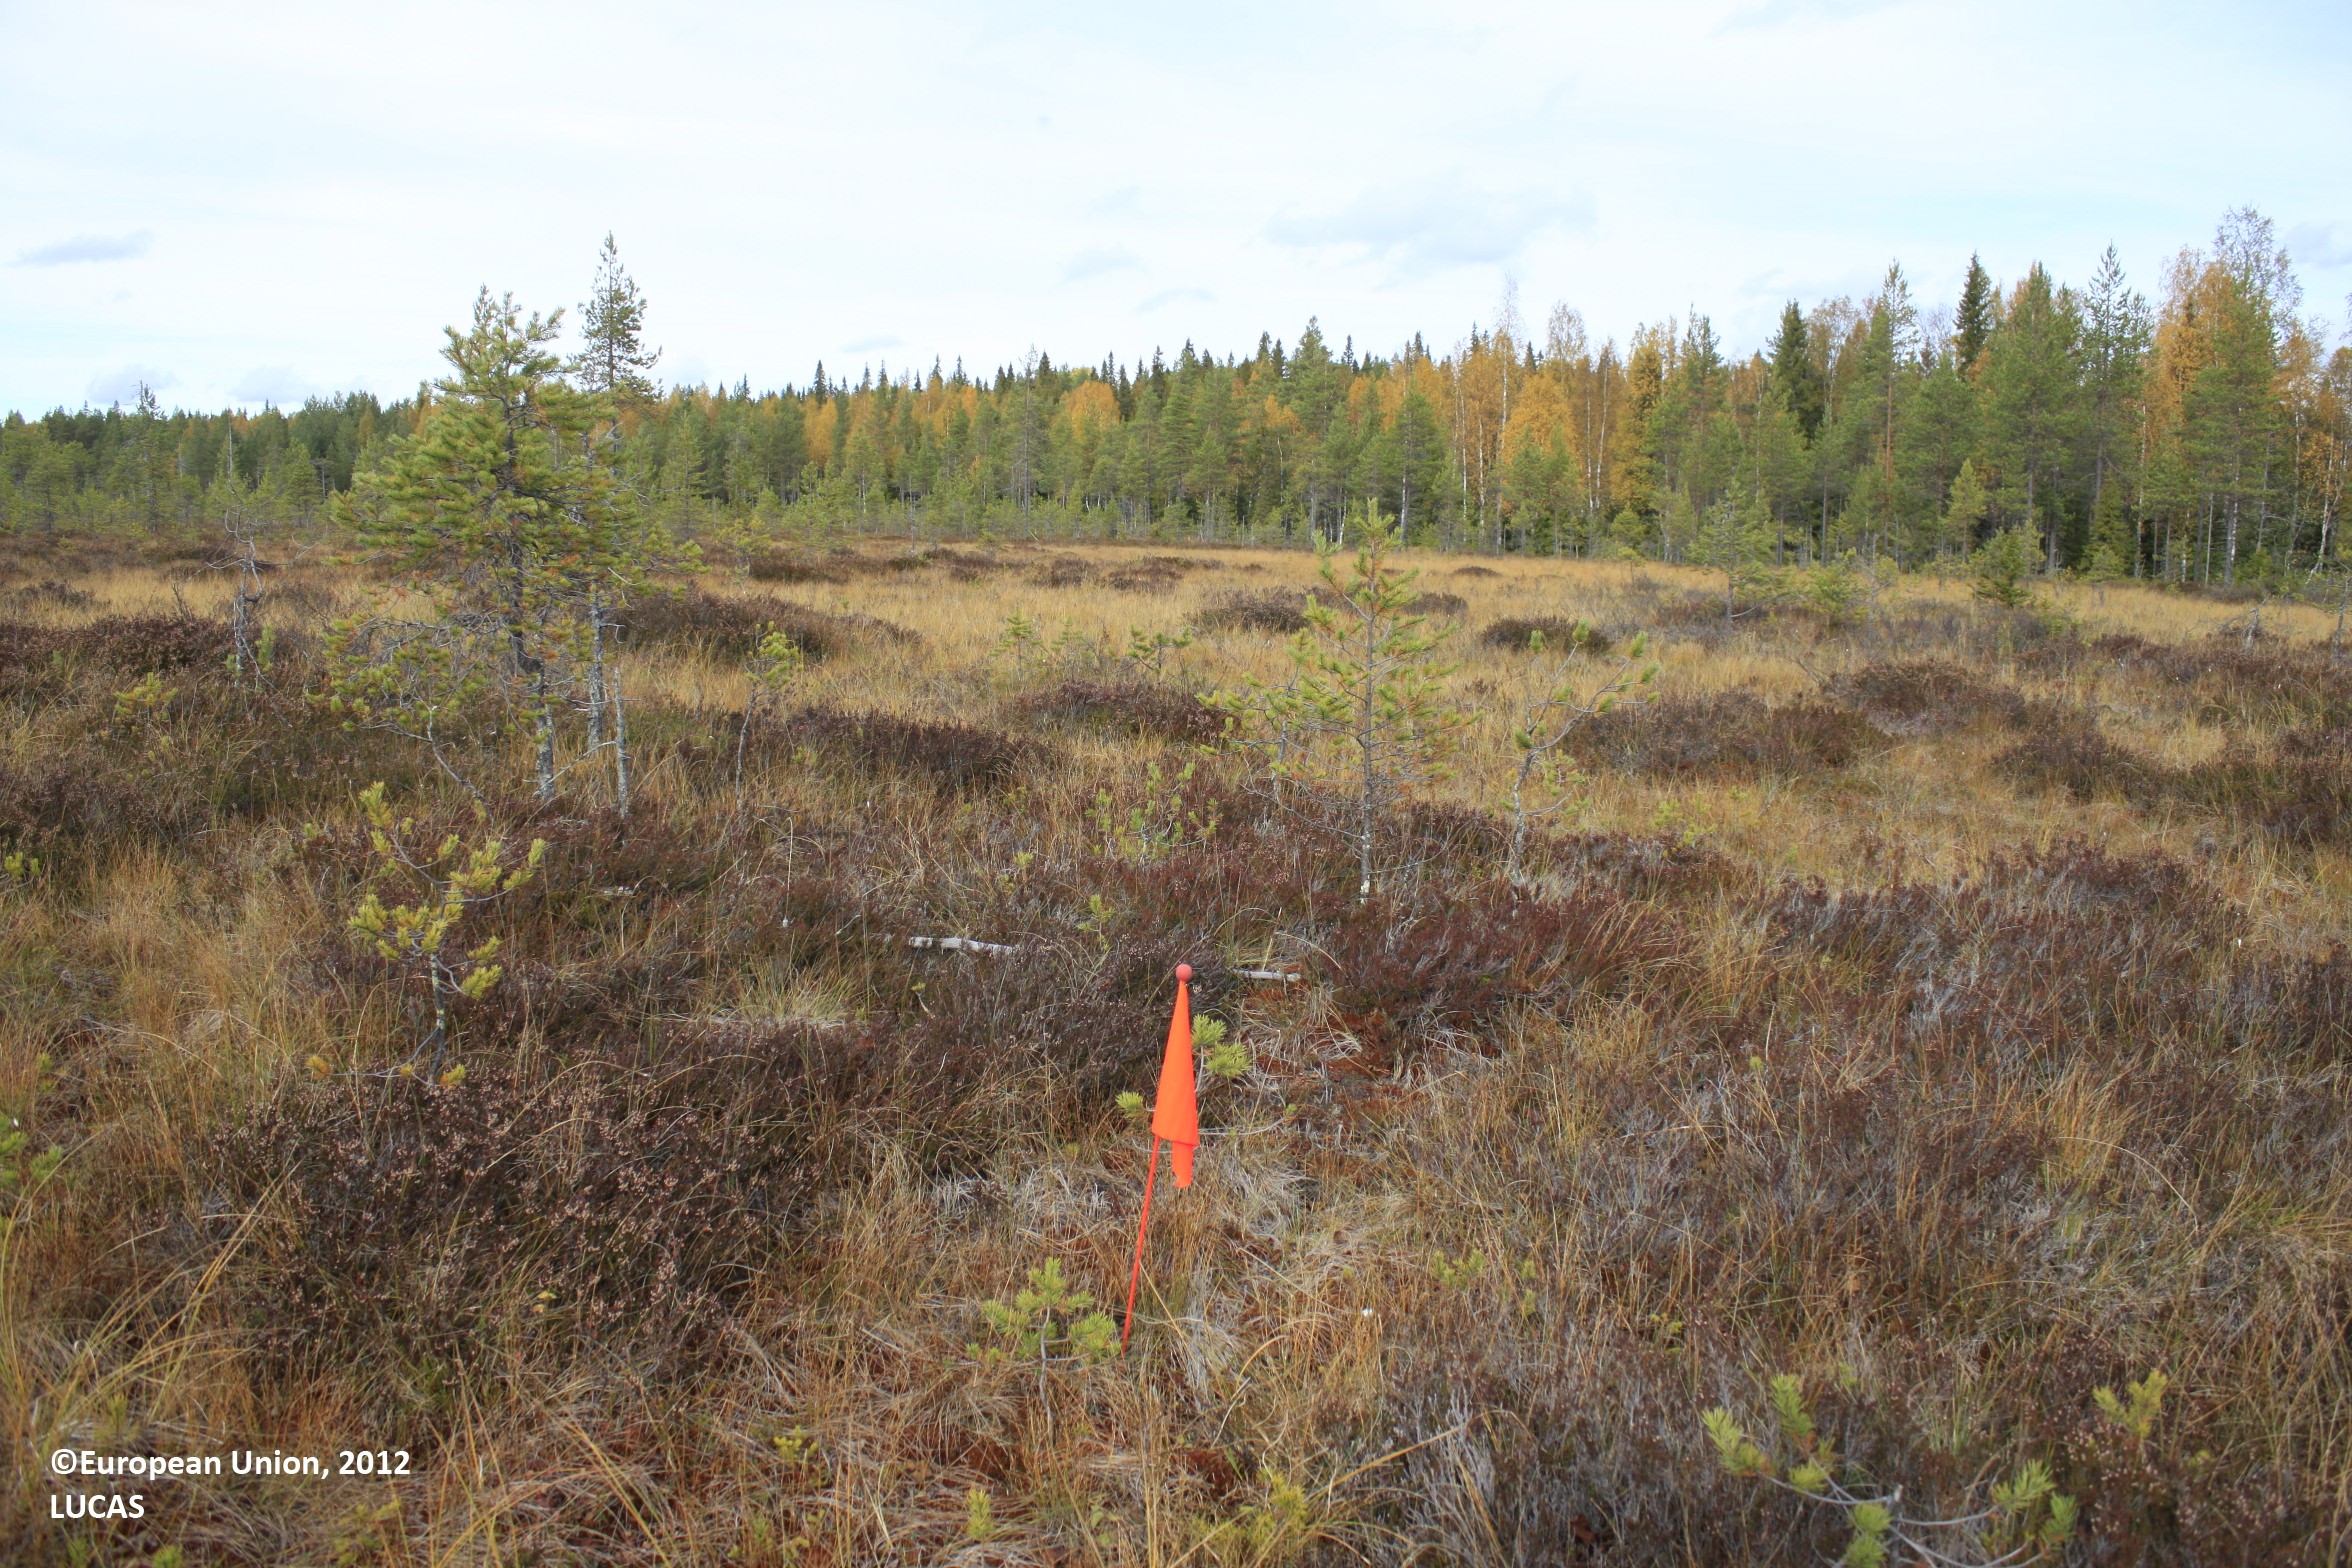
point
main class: Grassland
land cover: Grassland with sparse tree/shrub cover
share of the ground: 50 - 75 %
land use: Forestry
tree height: < 5 m
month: September
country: FI
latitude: 65.4754
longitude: 27.1992
